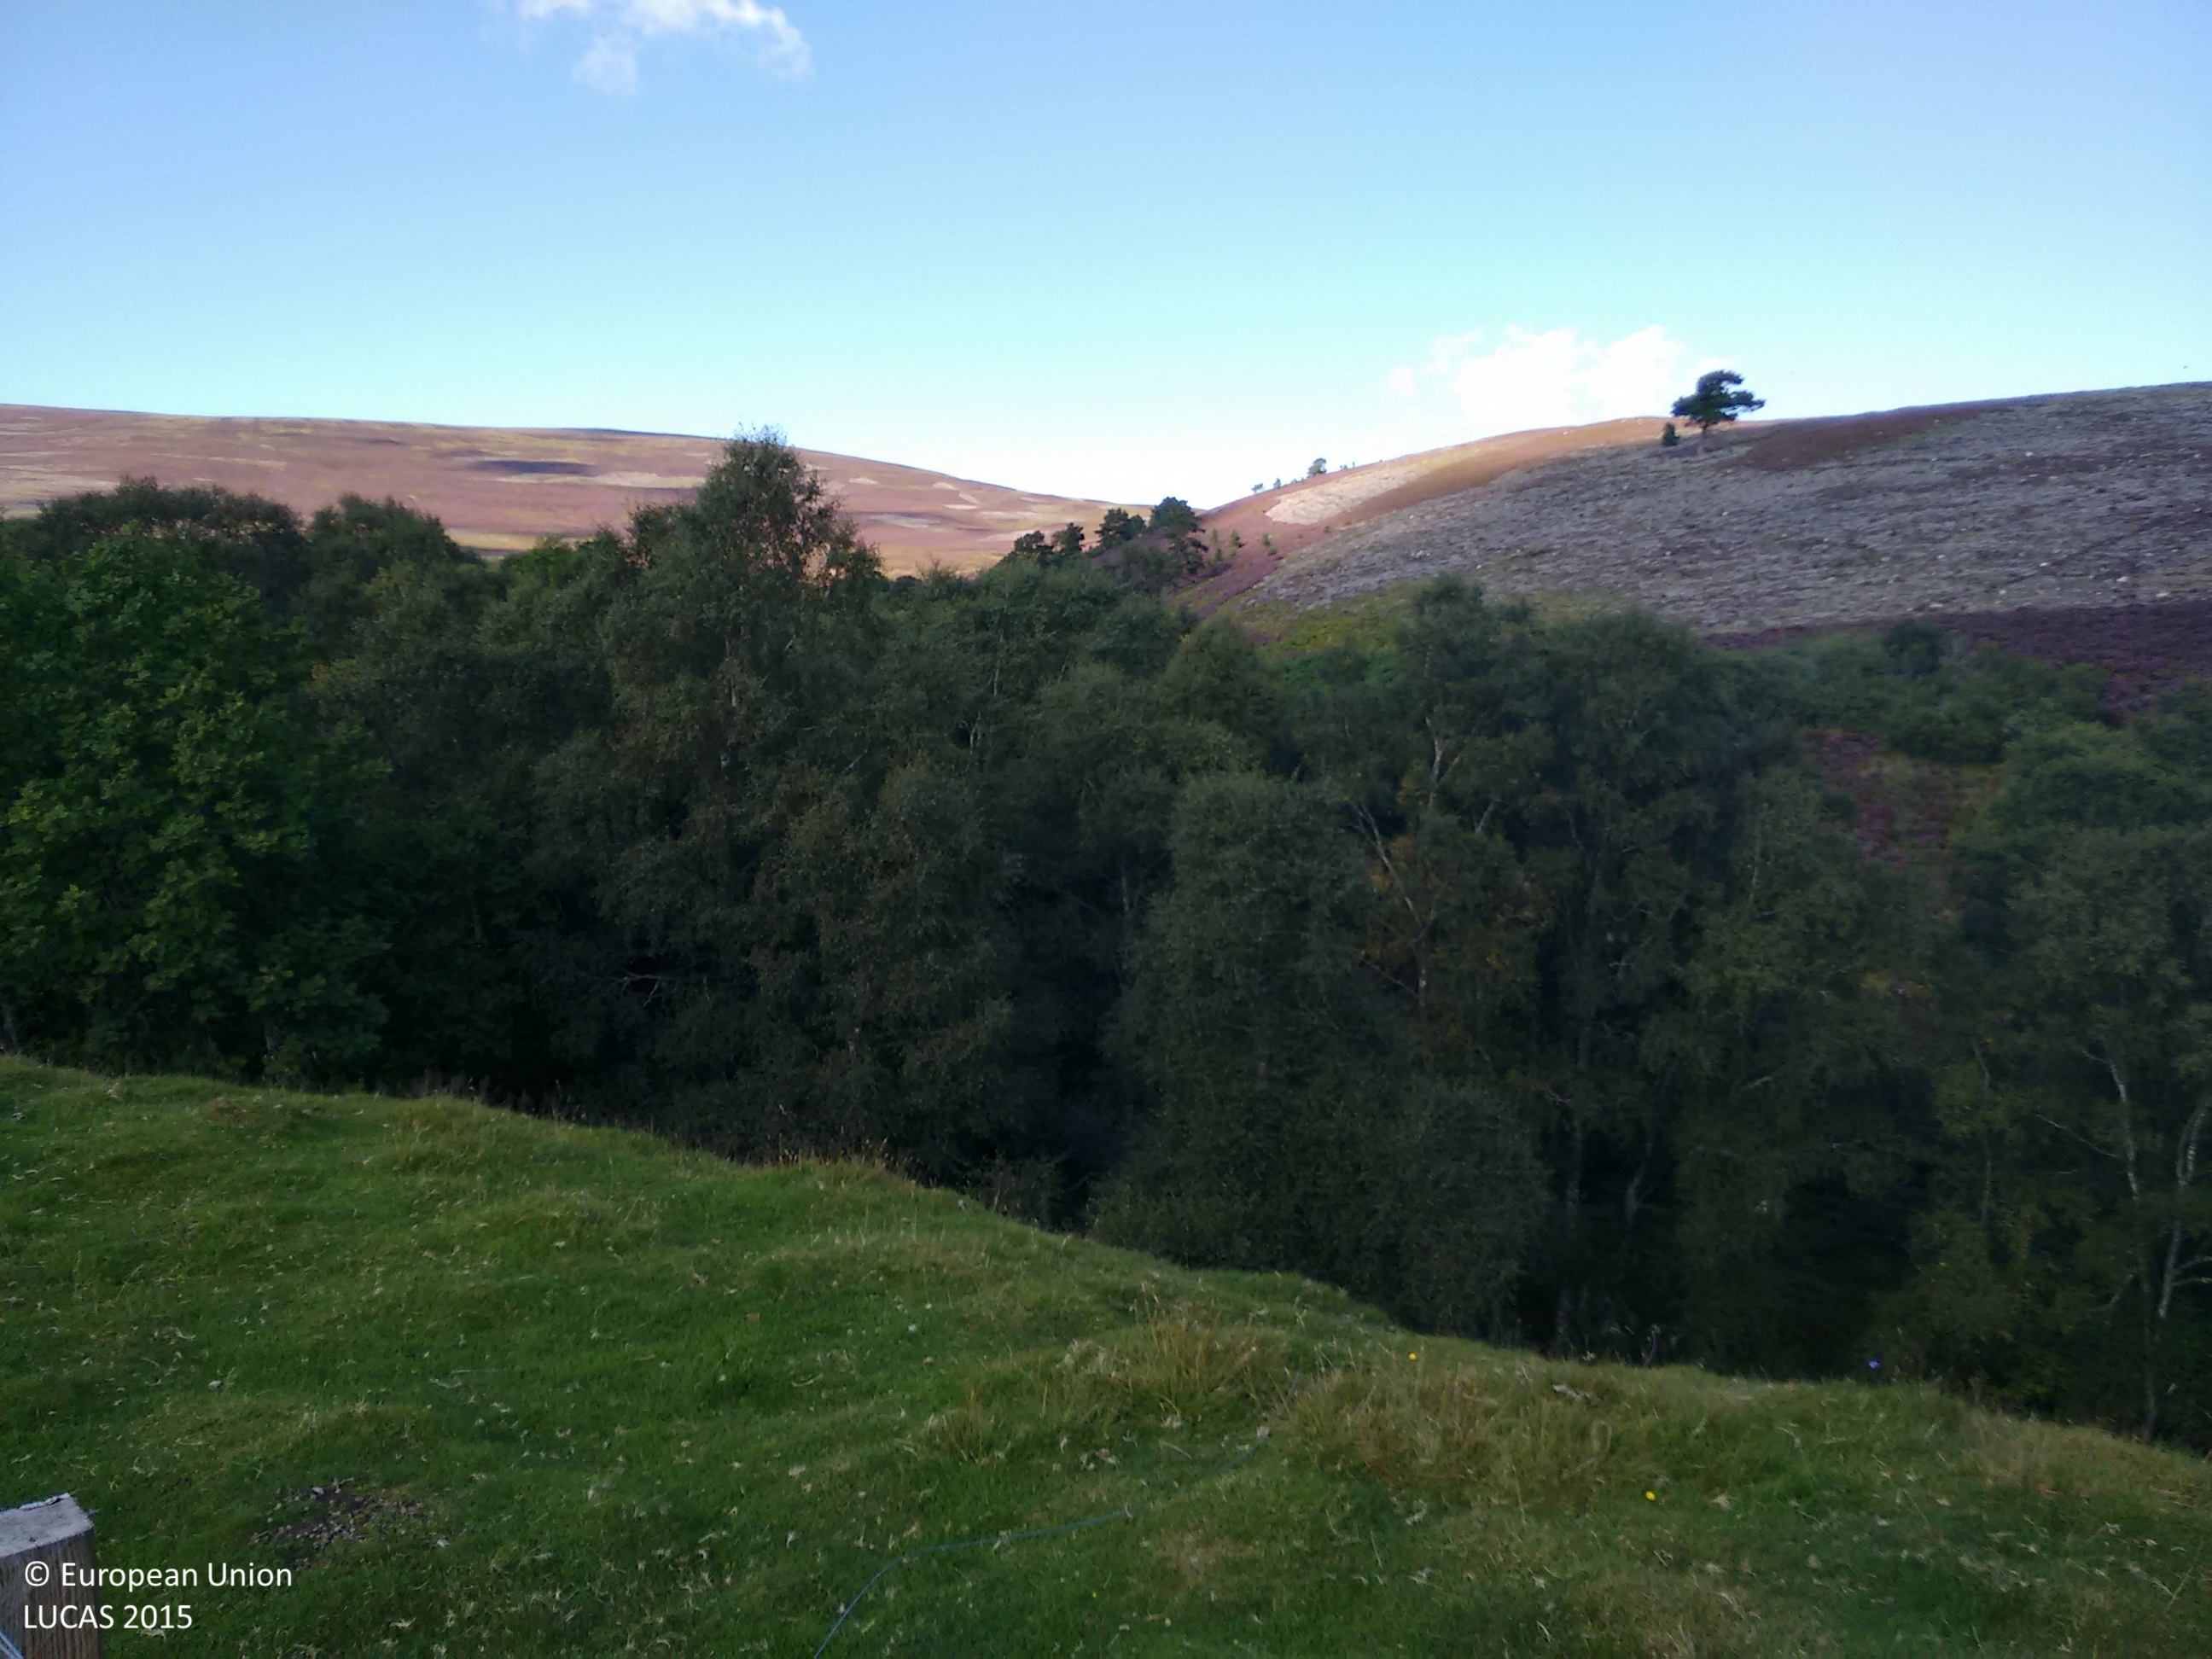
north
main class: Woodland
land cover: Broadleaved woodland
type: exotic forest
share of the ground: > 75 %
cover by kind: broadleaved forest trees 80 %, herbaceous plants 10 %
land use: Agriculture (excluding fallow land and kitchen gardens)
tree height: > 5 m
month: September
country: GB
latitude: 57.2826
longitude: -3.4577
